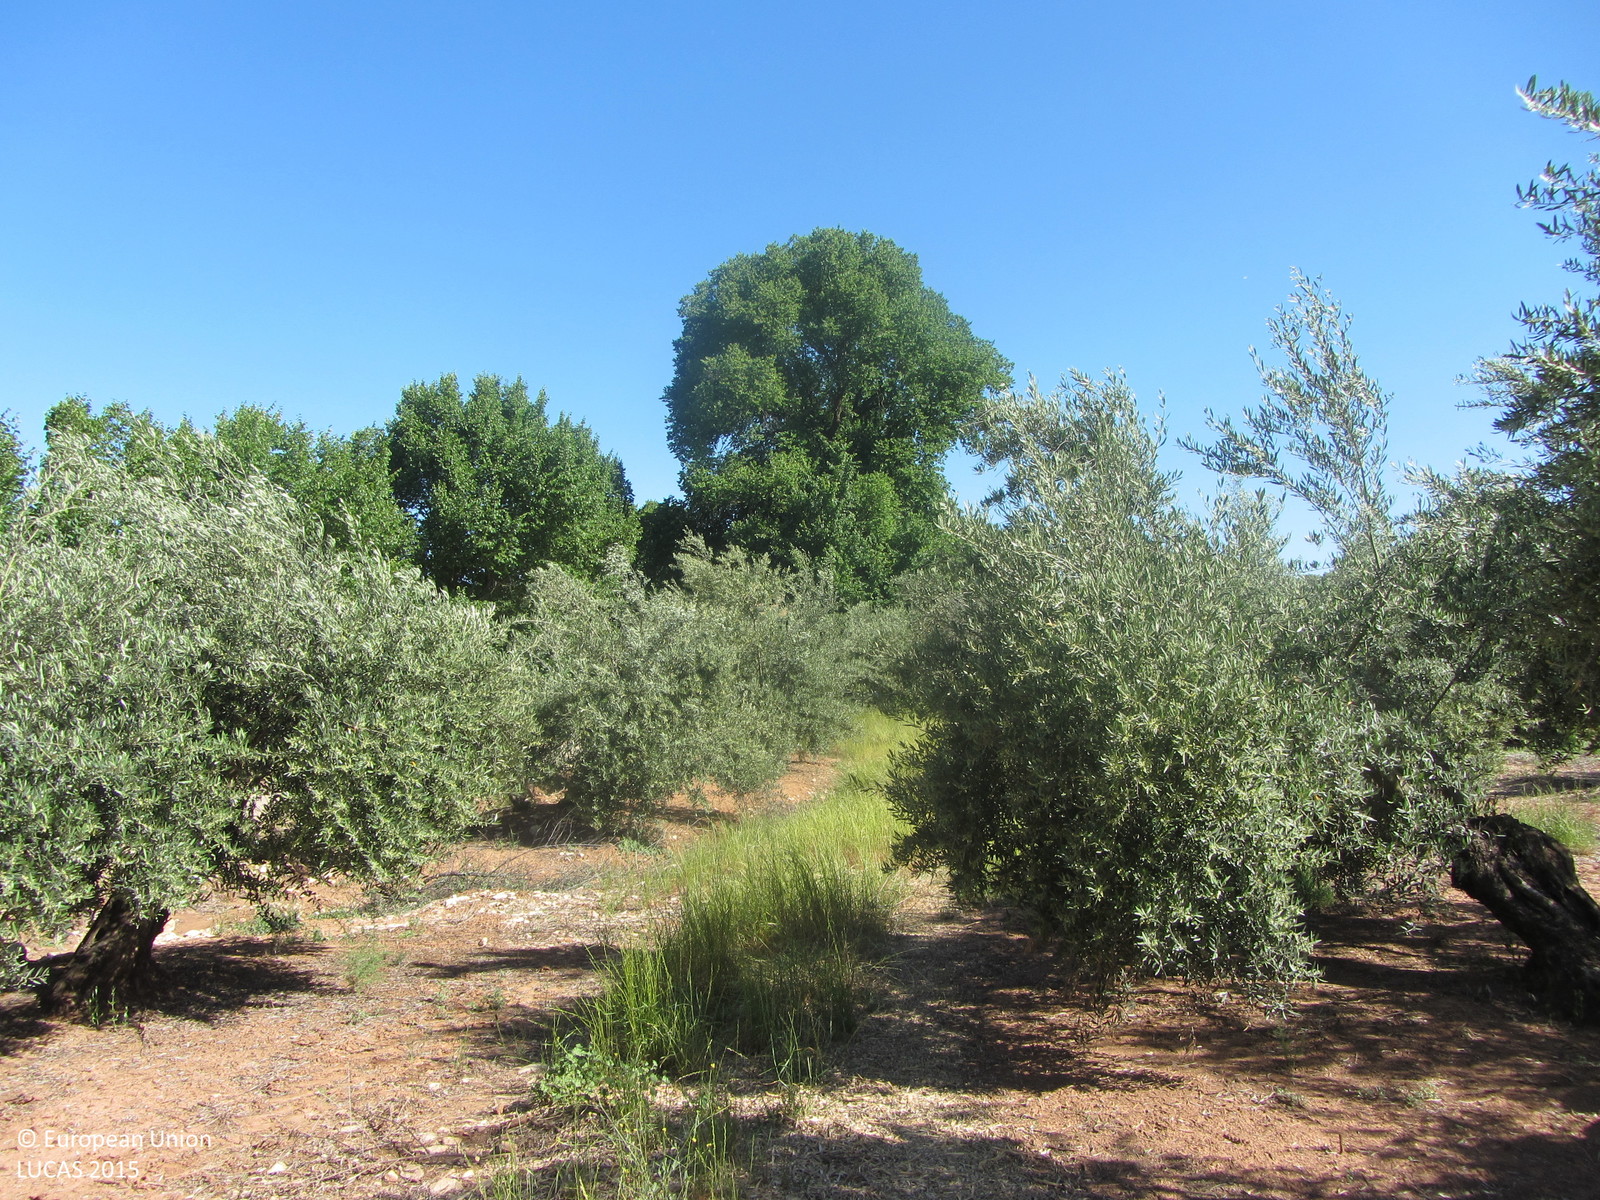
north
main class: Cropland
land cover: Olive groves
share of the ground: 25 - 50 %
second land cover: Spontaneously vegetated surfaces
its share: 10 - 25 %
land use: Agriculture (excluding fallow land and kitchen gardens)
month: May
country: ES
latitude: 38.2272
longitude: -3.1262
